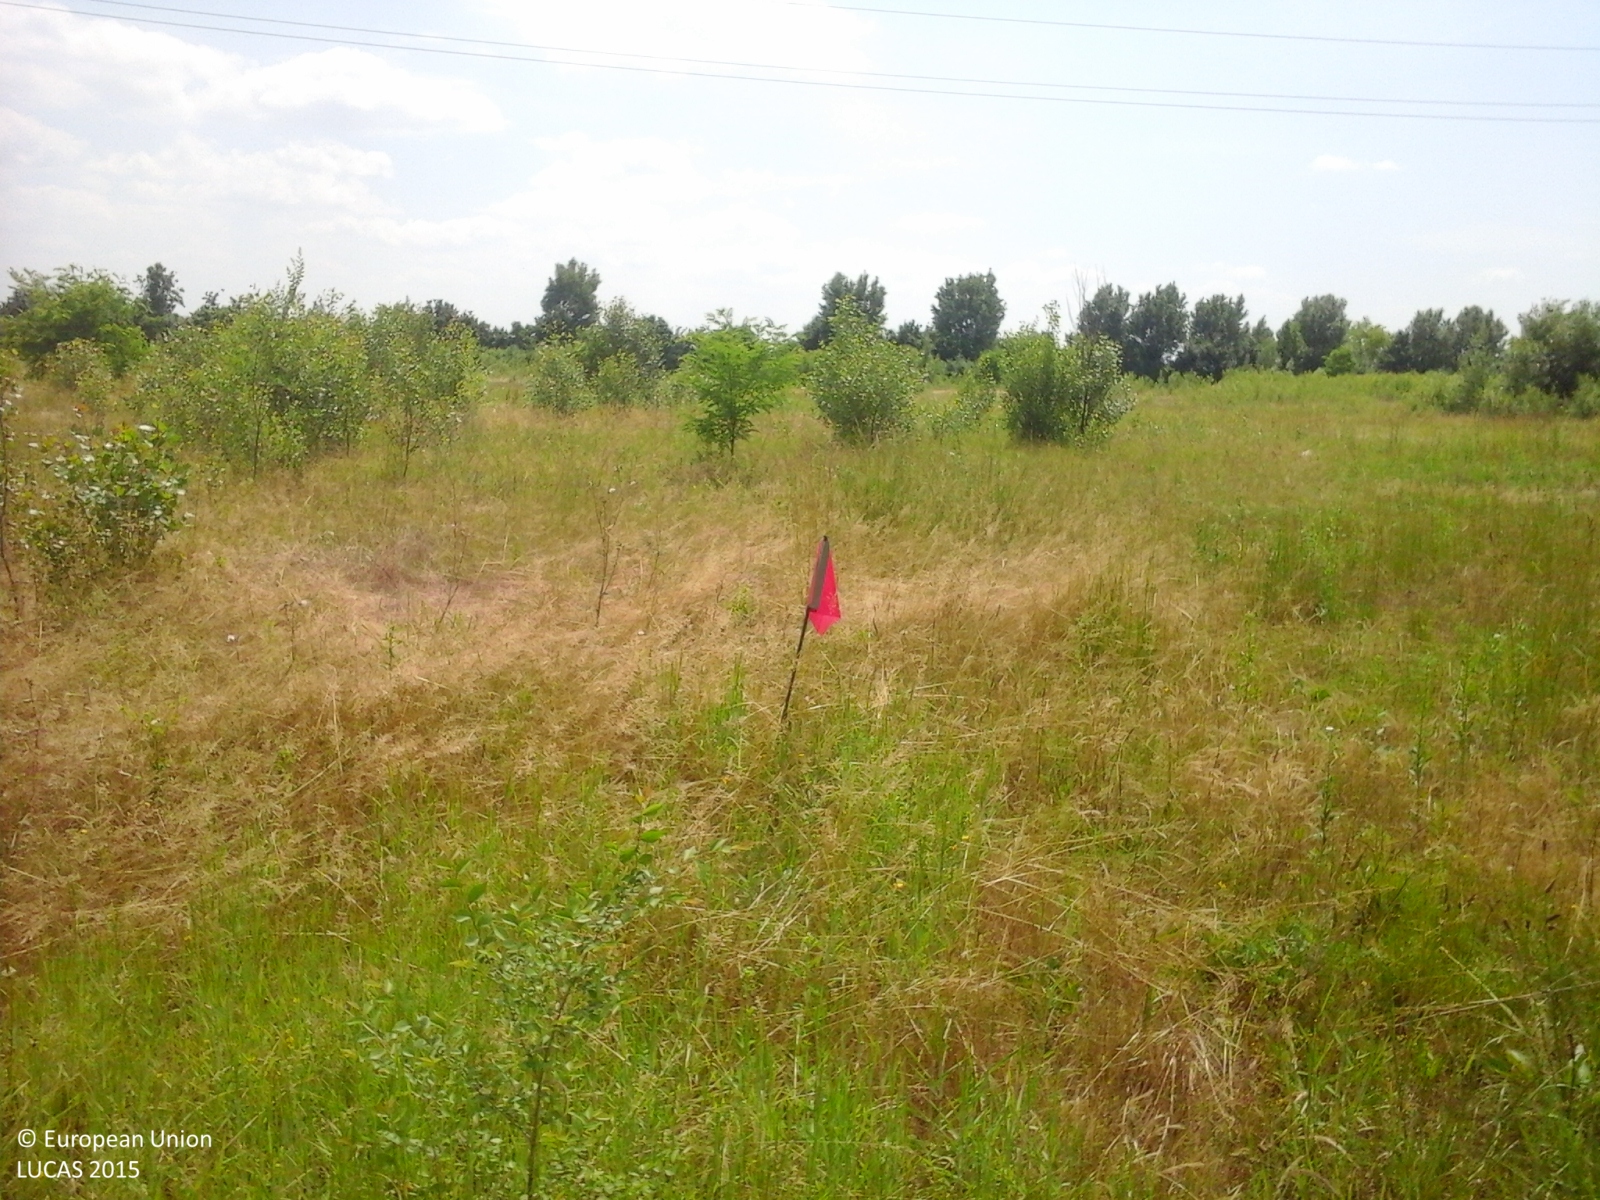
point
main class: Grassland
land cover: Grassland with sparse tree/shrub cover
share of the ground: > 75 %
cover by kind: herbaceous plants 95 %, broadleaved forest trees 5 %
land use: Abandoned areas
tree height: < 5 m
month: May
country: IT
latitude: 45.6556
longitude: 11.5247
